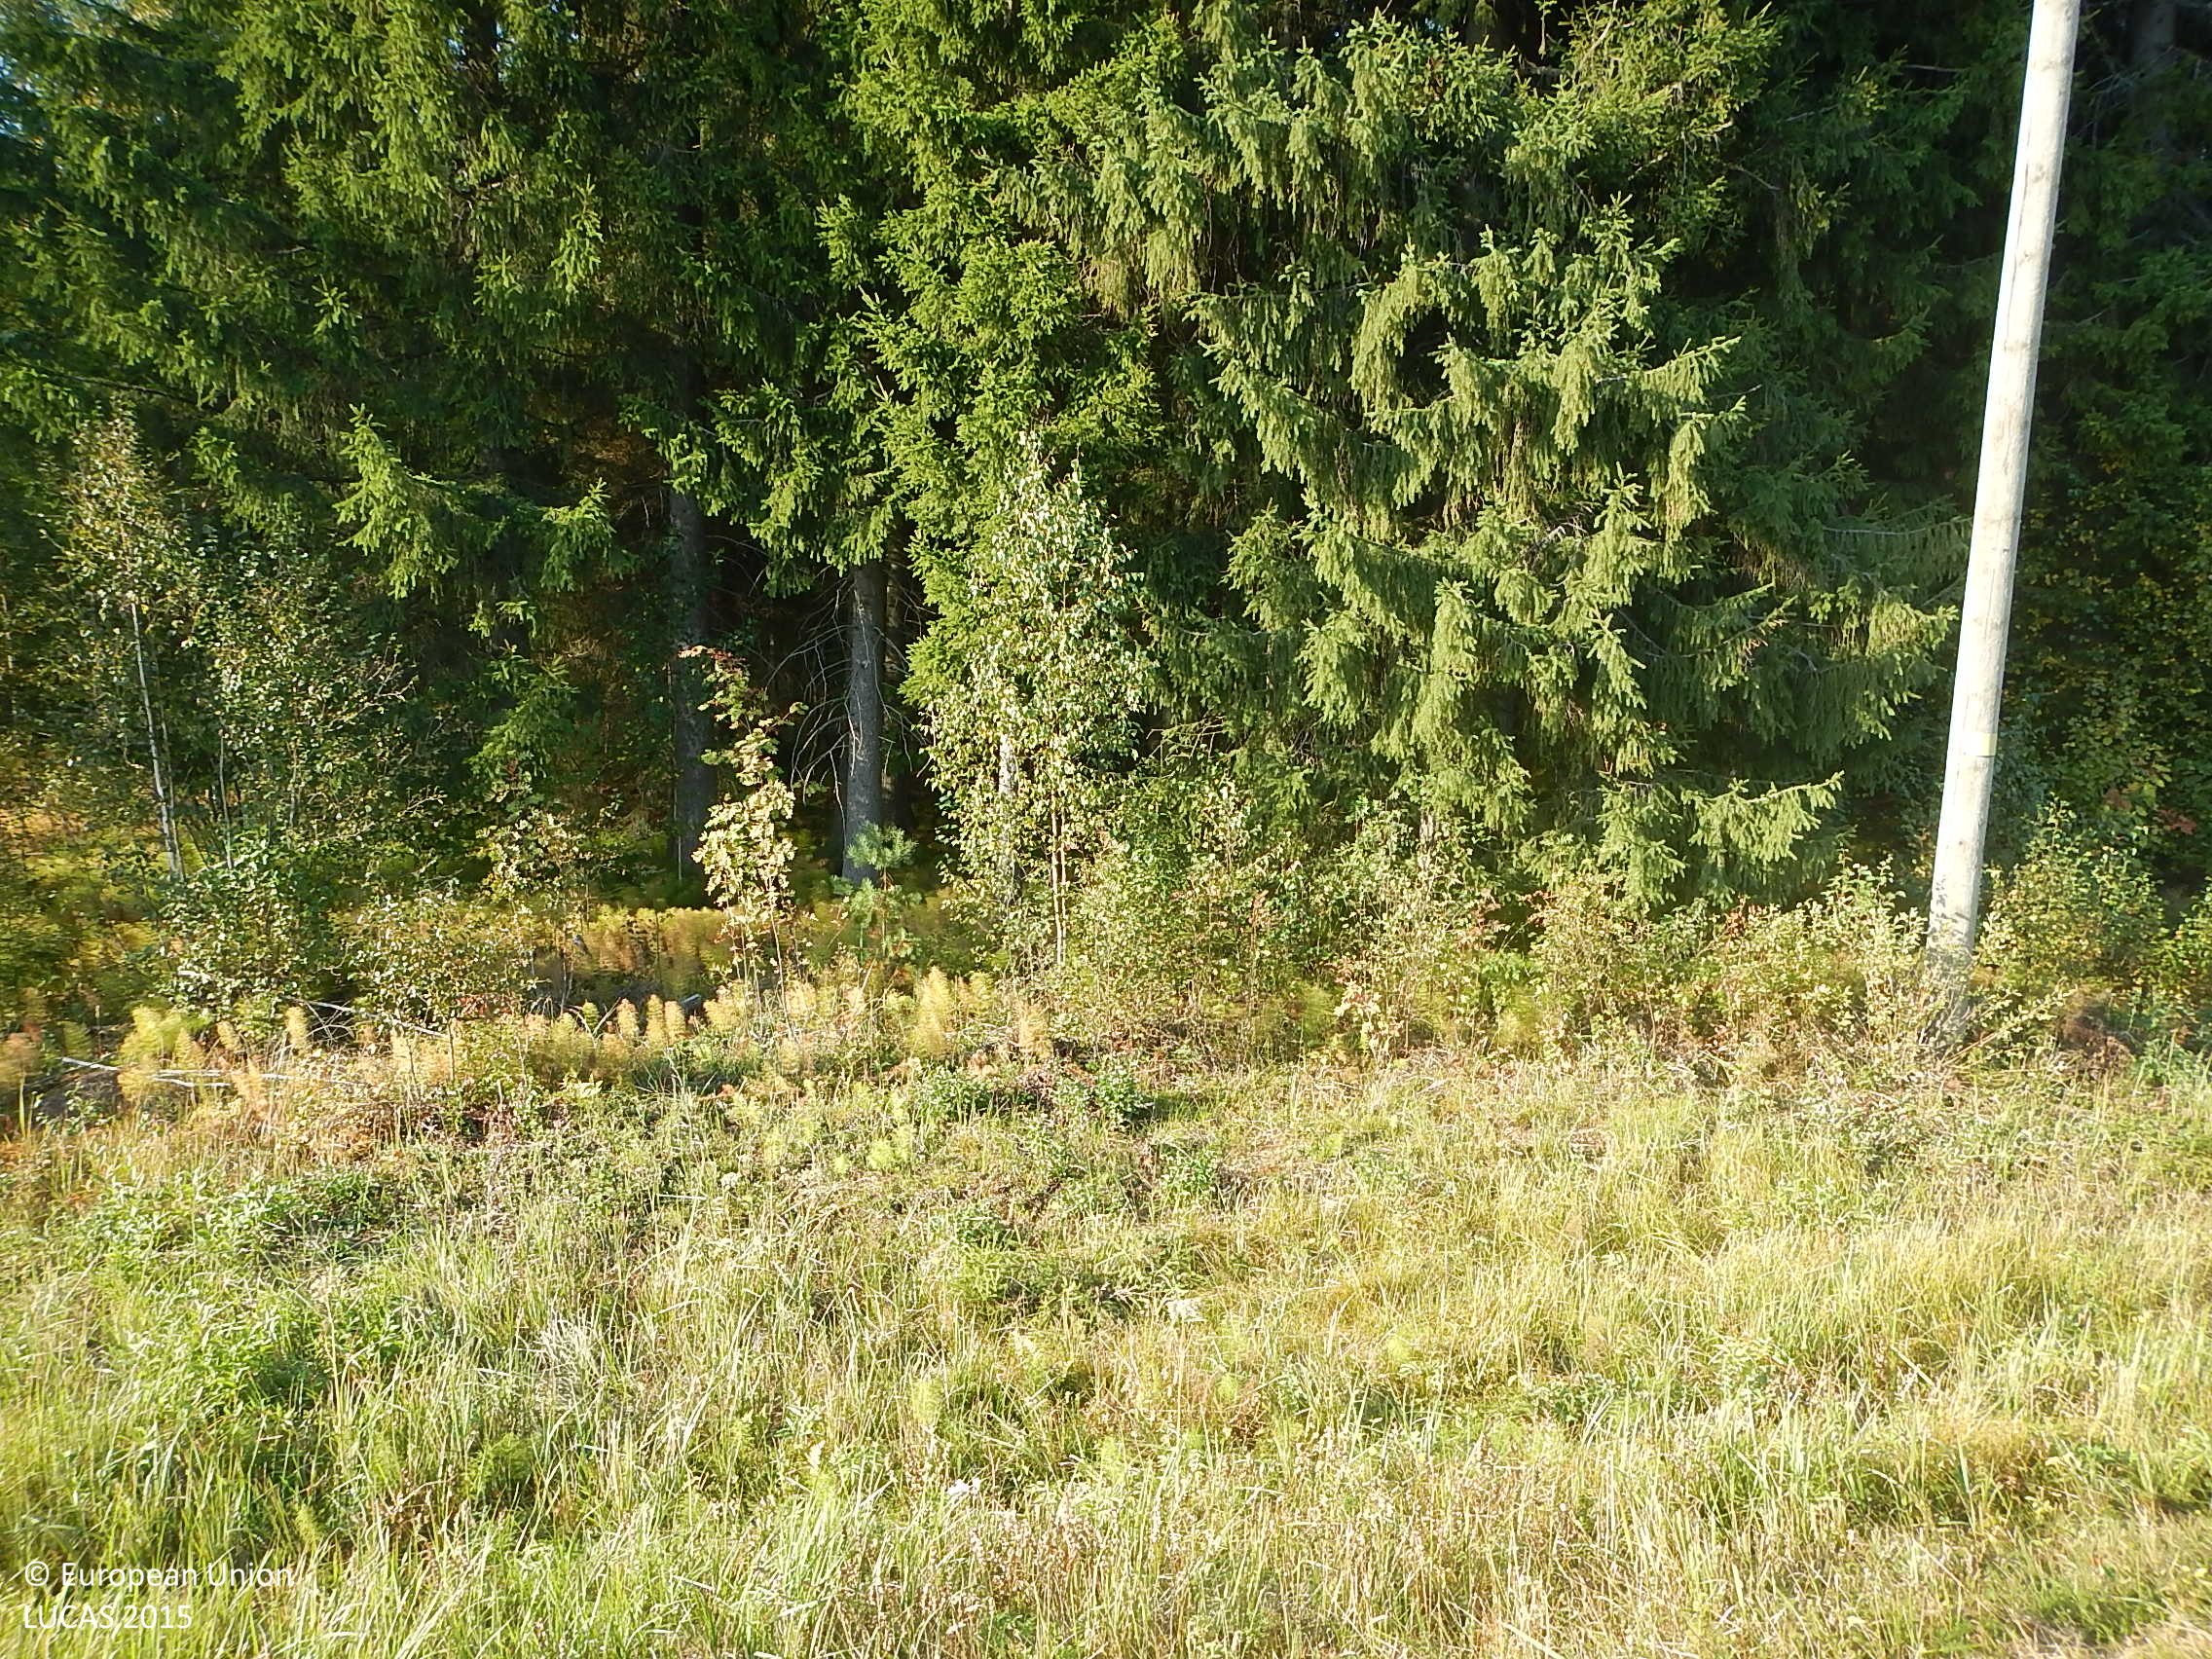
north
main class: Grassland
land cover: Grassland without tree/shrub cover
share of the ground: > 75 %
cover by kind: herbaceous plants 100 %
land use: Road transport
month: September
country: FI
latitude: 61.4780
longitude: 22.5868
